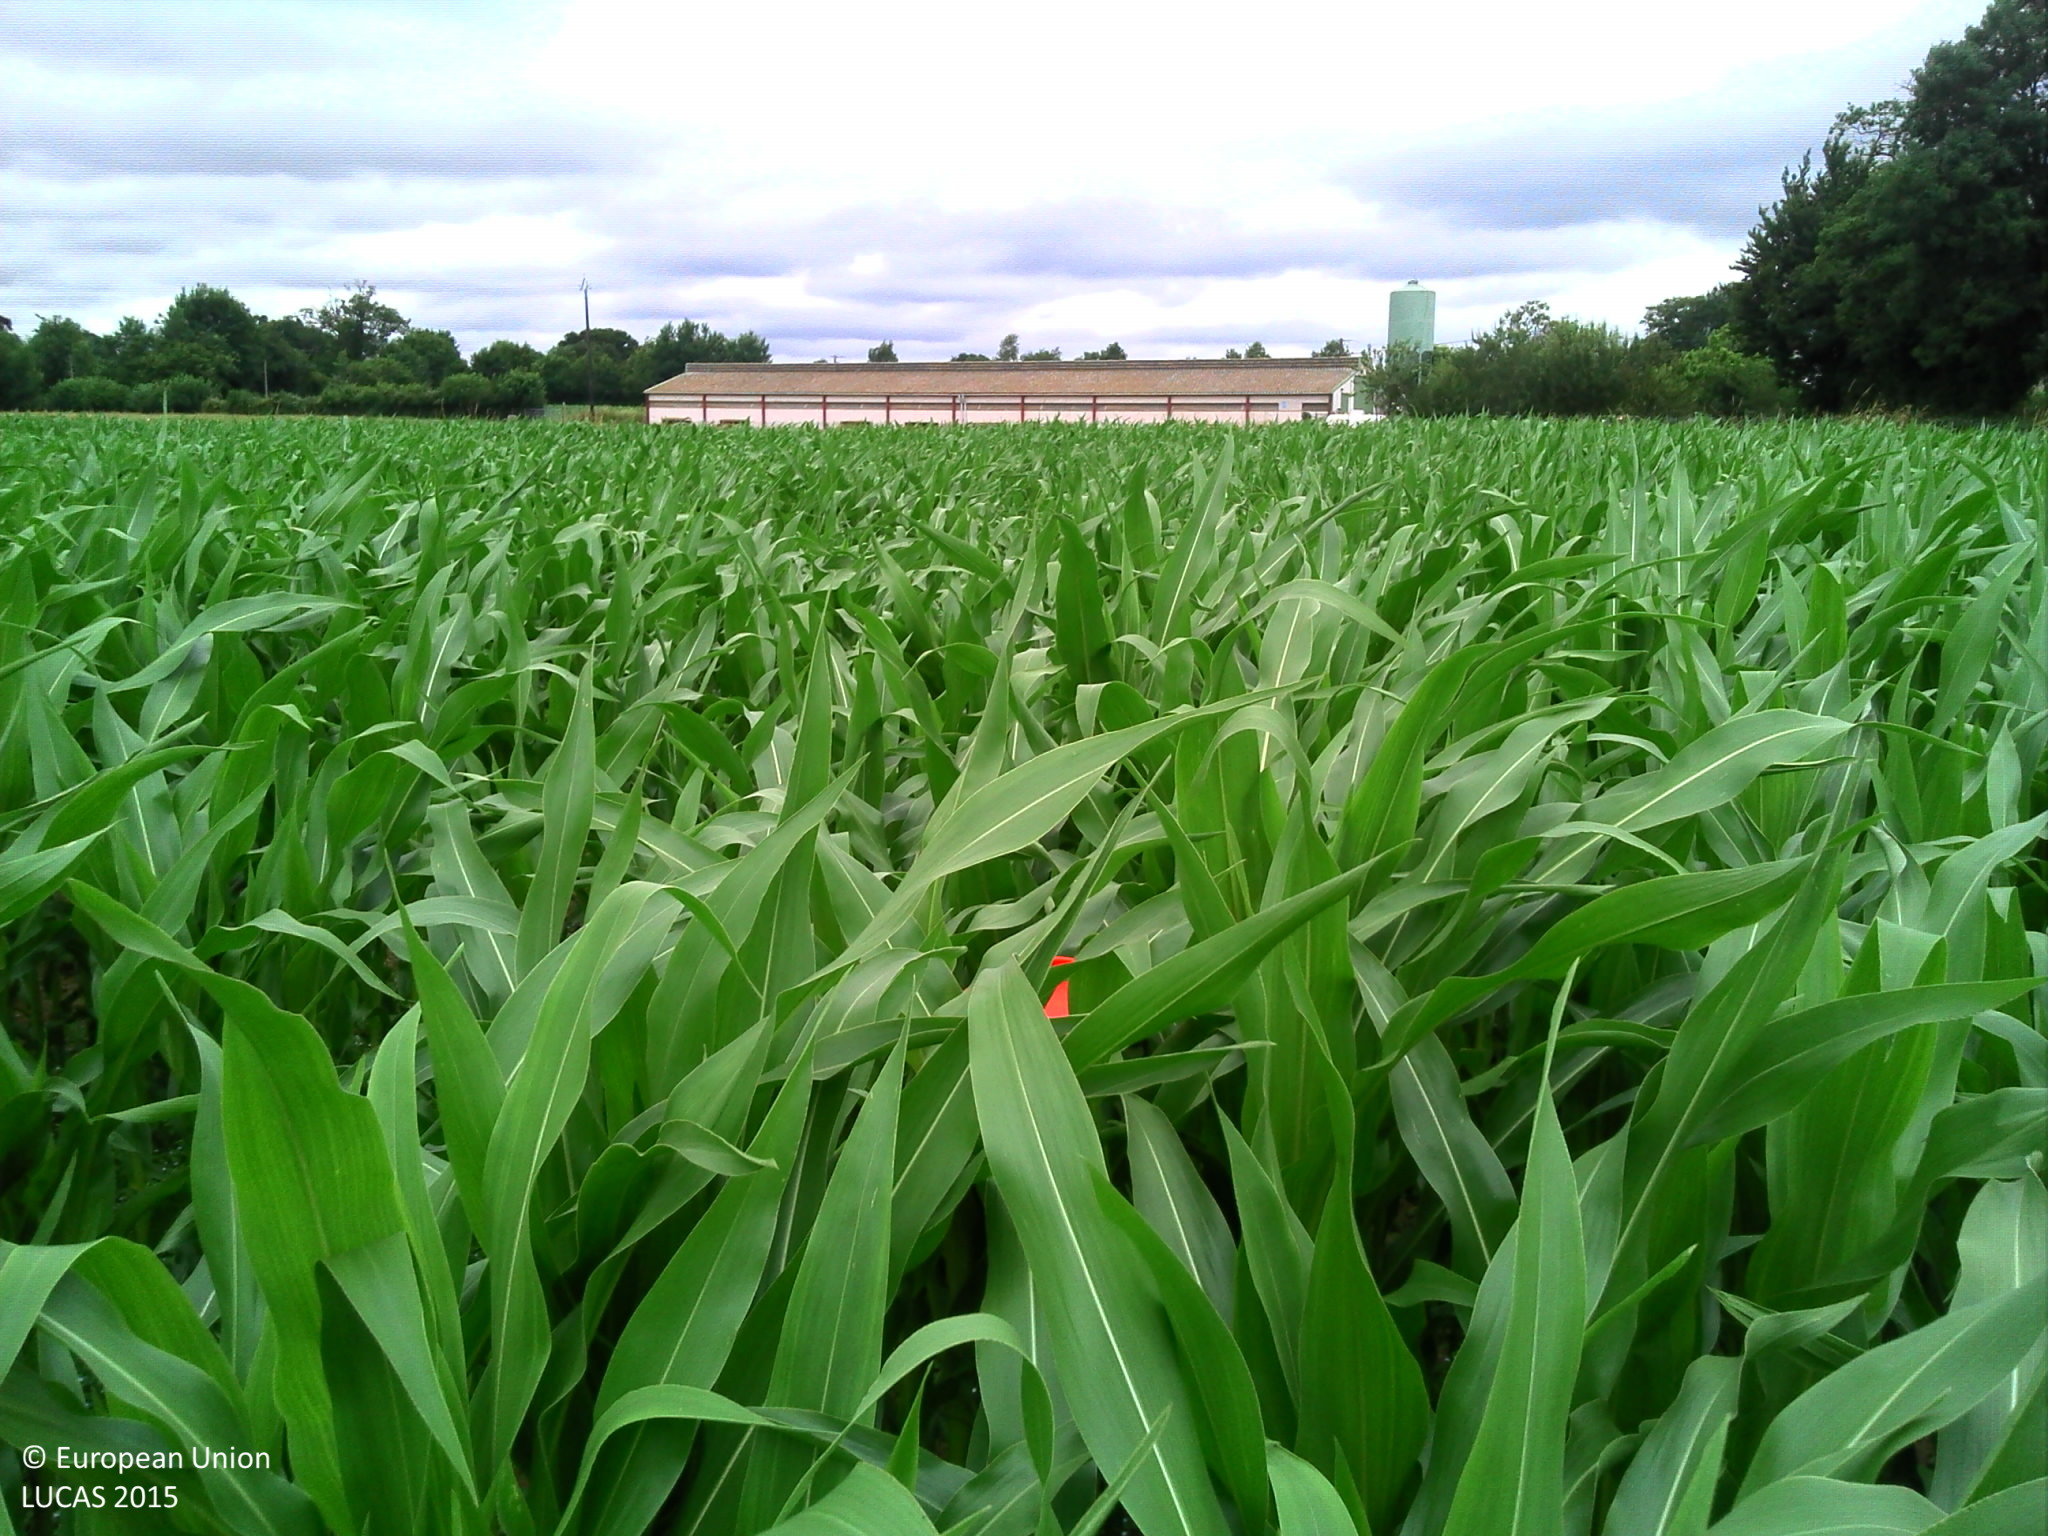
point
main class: Cropland
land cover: Maize
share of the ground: > 75 %
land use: Agriculture (excluding fallow land and kitchen gardens)
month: July
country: FR
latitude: 48.9446
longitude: -1.3377
